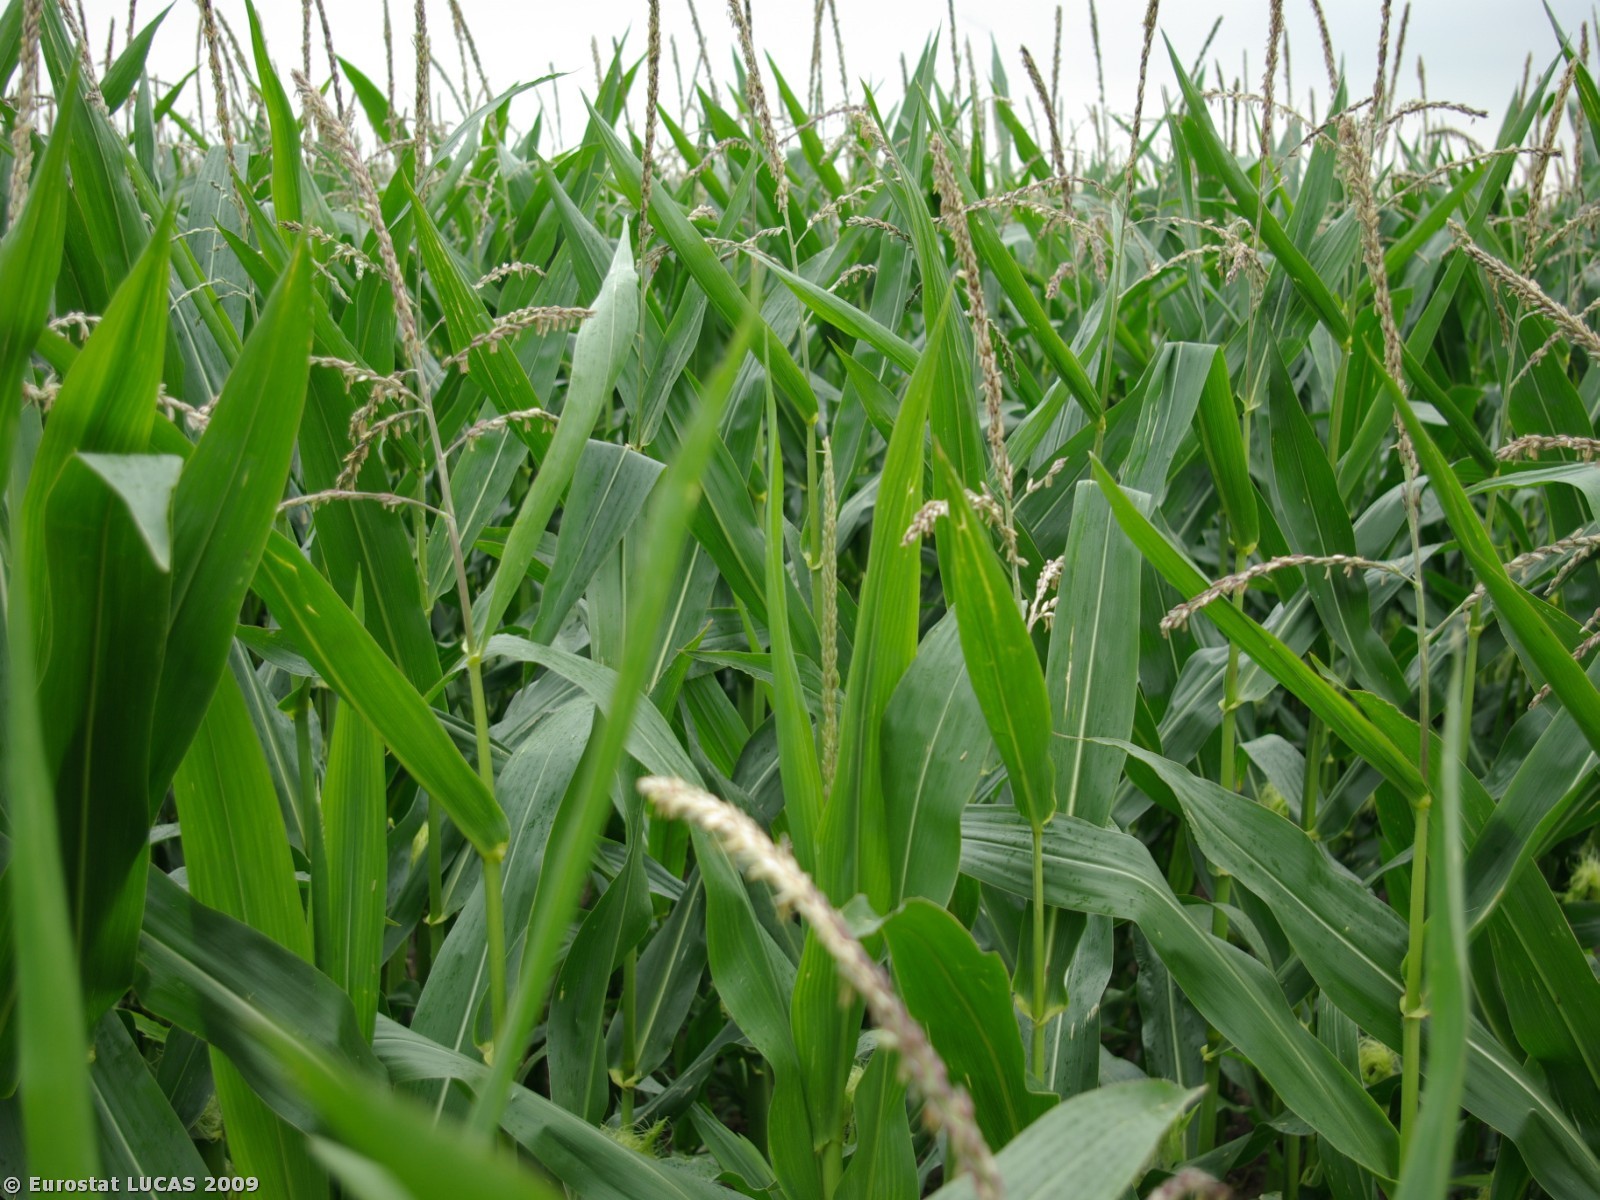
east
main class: Cropland
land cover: Maize
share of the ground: > 75 %
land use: Agriculture (excluding fallow land and kitchen gardens)
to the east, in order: Maize
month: July
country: DK
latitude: 55.1574
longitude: 8.7925
